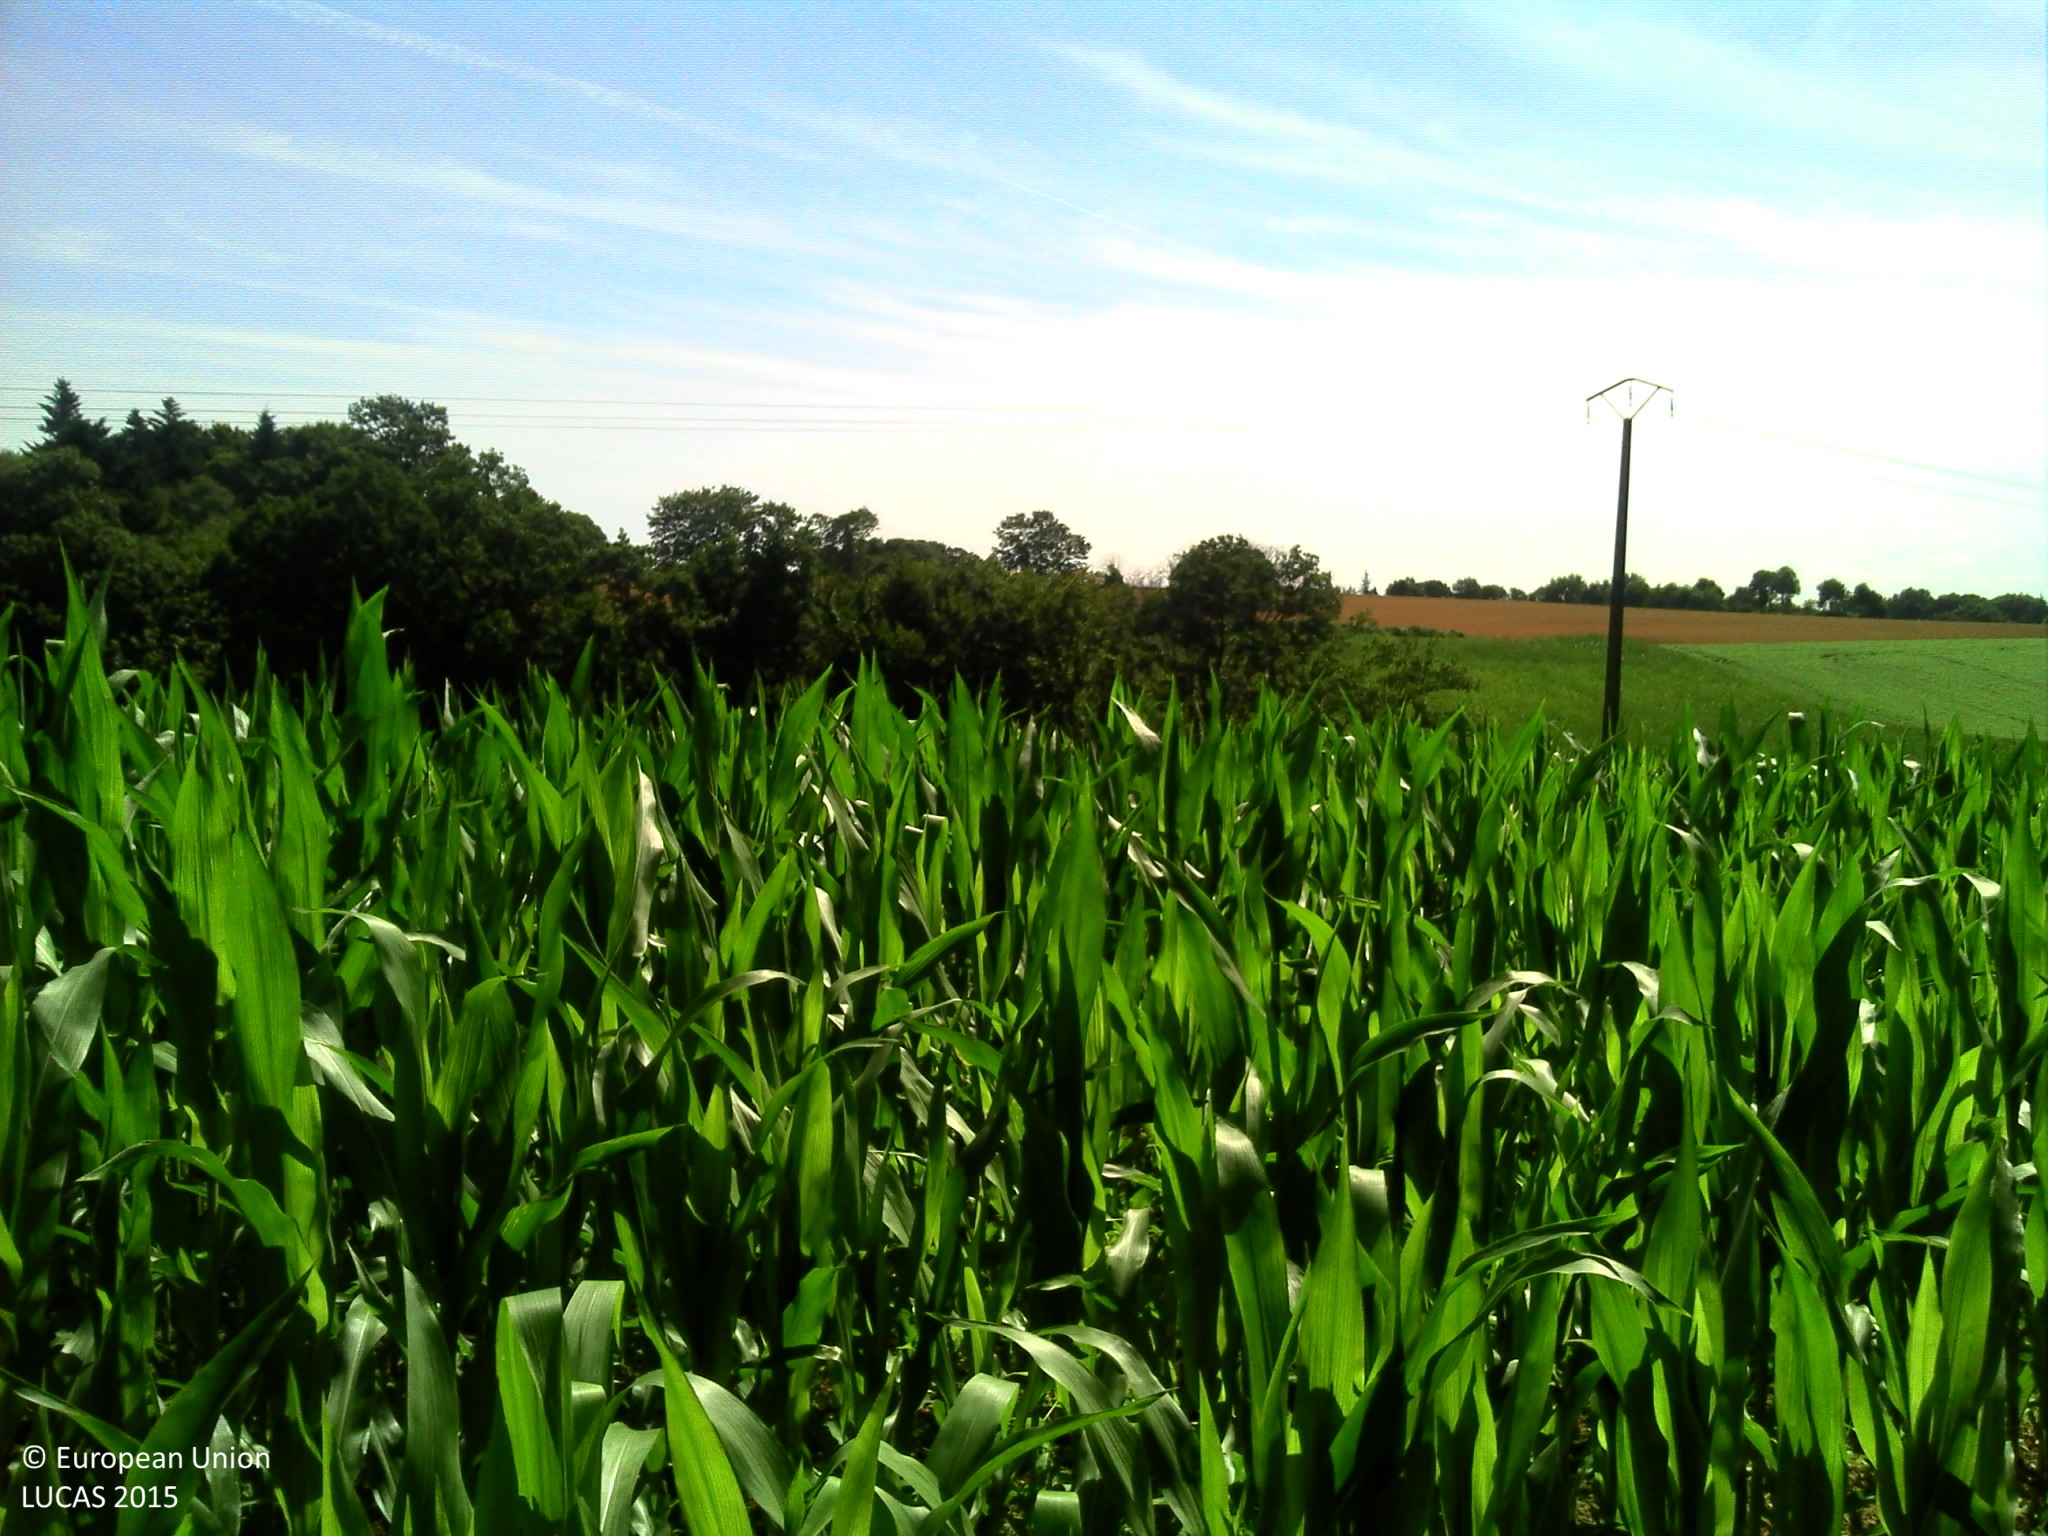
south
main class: Cropland
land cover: Maize
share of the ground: > 75 %
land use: Agriculture (excluding fallow land and kitchen gardens)
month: July
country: FR
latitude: 48.0703
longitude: -2.9922
